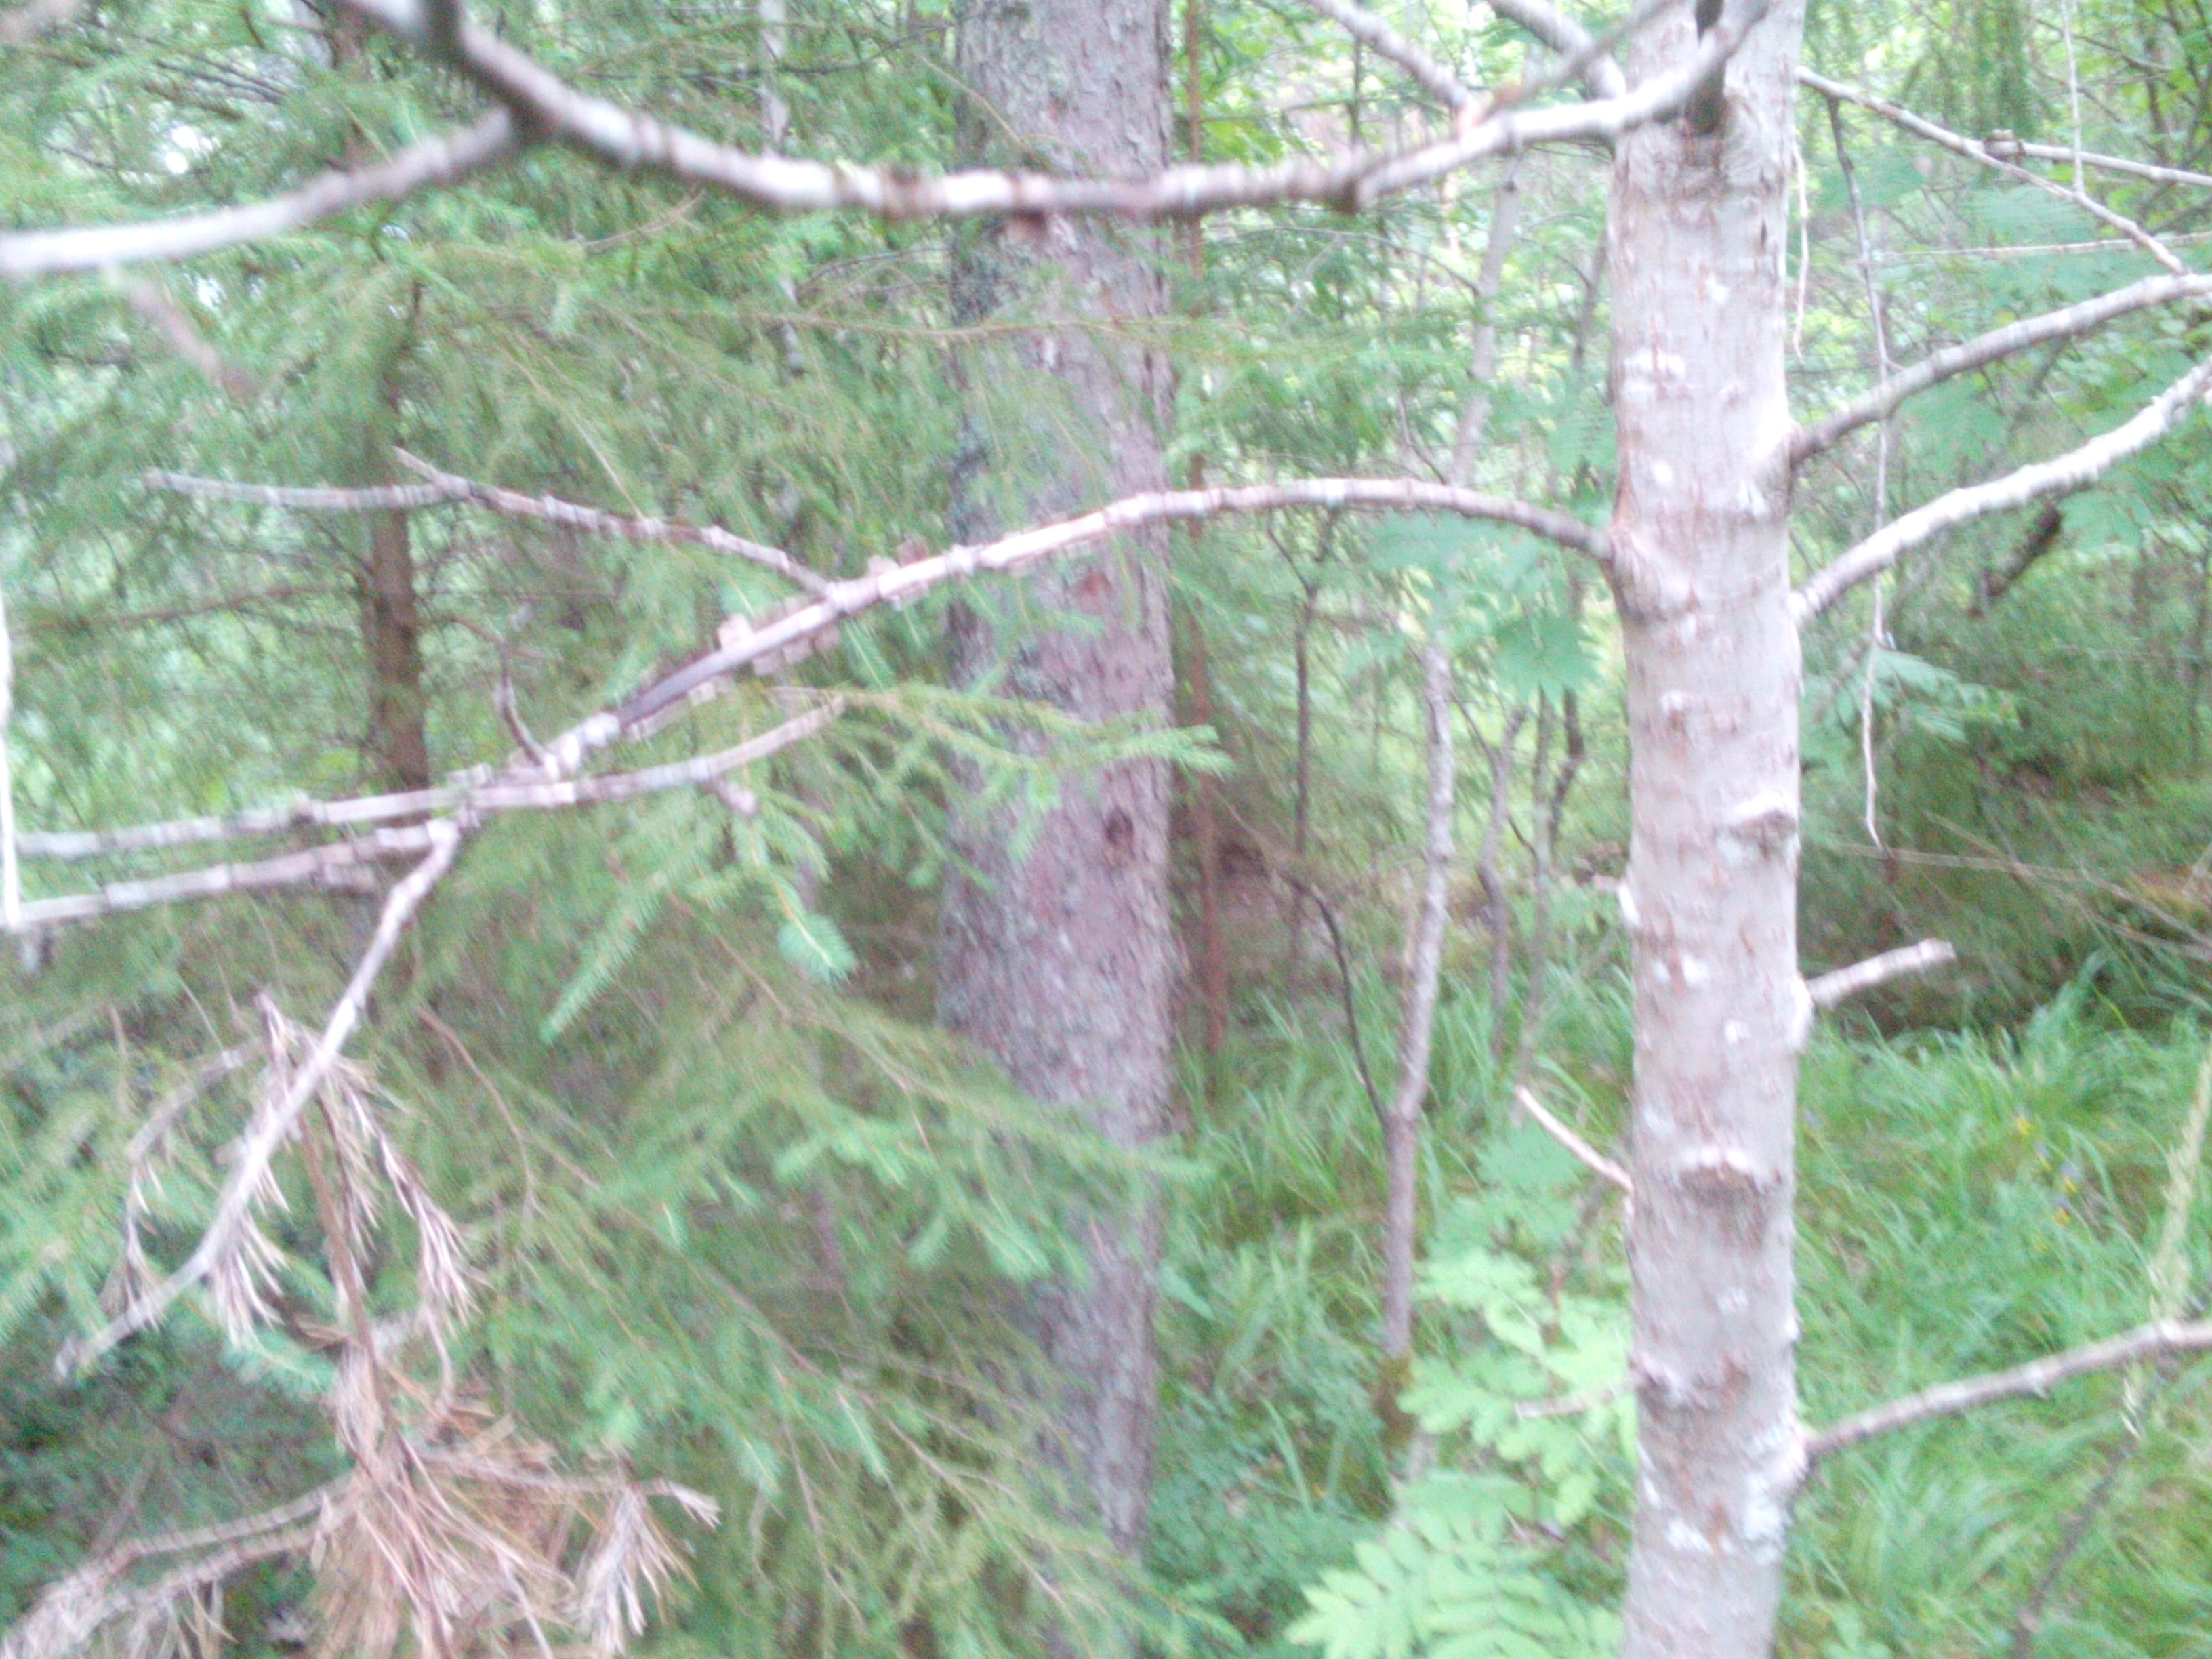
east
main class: Woodland
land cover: Spruce dominated mixed woodland
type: hemiboreal forest and nemoral coniferous forest and mixed broadleaved-coniferous forest
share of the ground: > 75 %
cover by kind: broadleaved forest trees 55 %, coniferous forest trees 30 %, herbaceous plants 10 %, shrubs 5 %
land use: Forestry
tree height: > 5 m
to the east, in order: Spruce dominated mixed woodland; Tracks; Spruce dominated coniferous woodland; Spruce dominated mixed woodland; Broadleaved woodland; Spruce dominated coniferous woodland
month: July
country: LV
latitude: 56.9122
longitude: 22.2212
